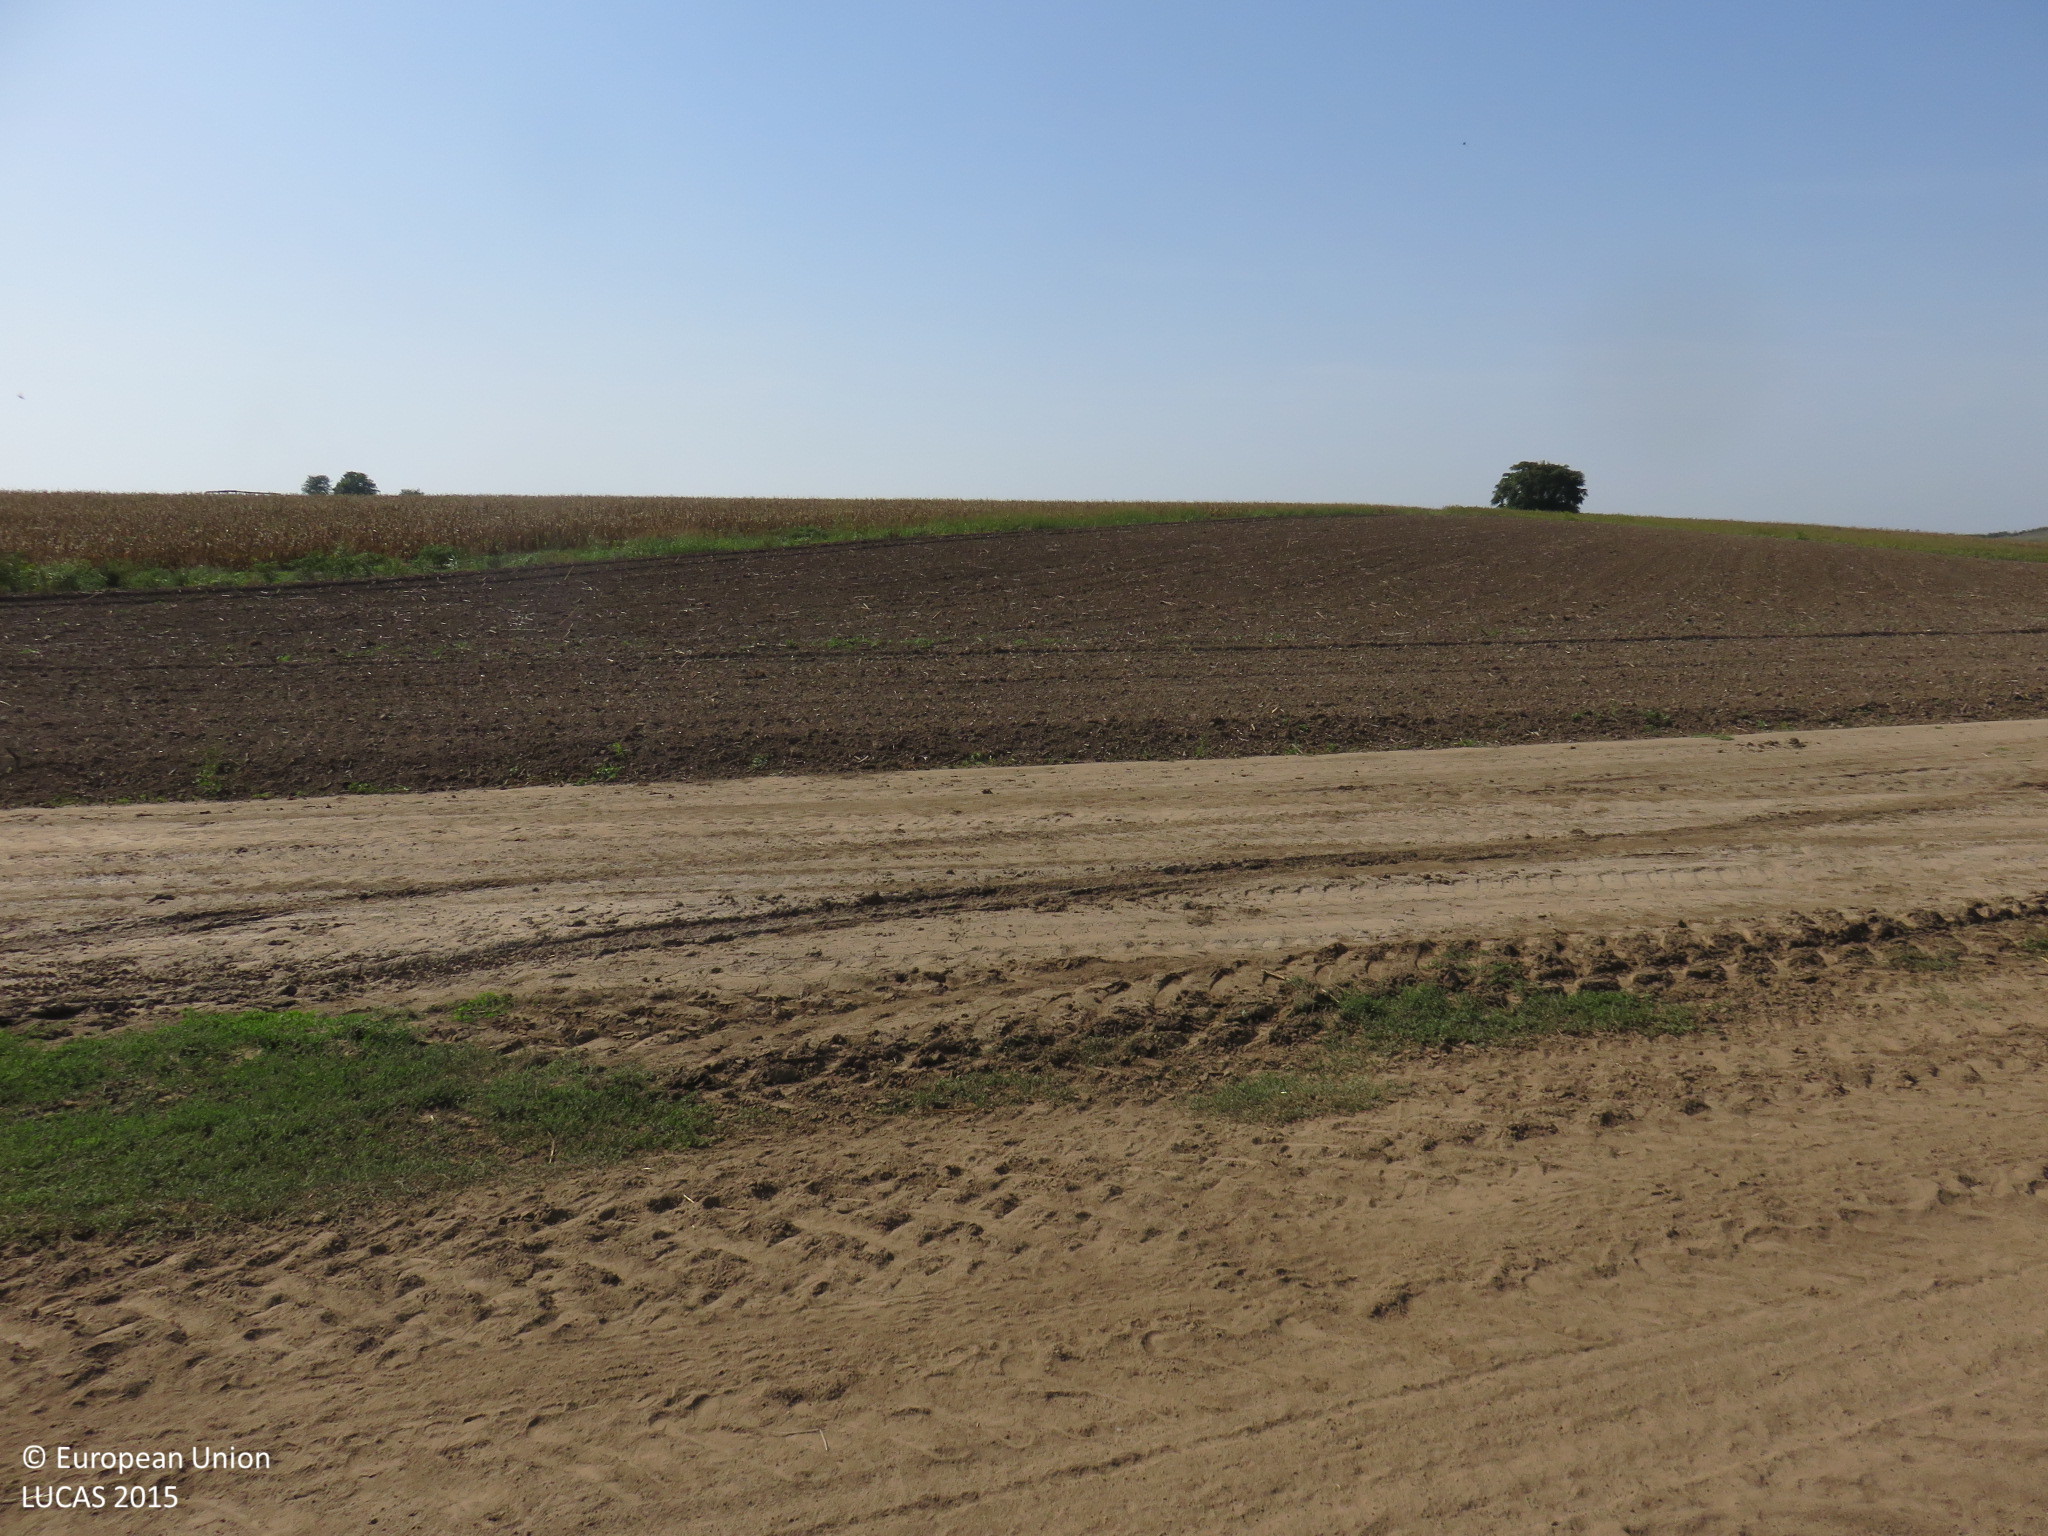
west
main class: Cropland
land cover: Maize
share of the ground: > 75 %
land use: Agriculture (excluding fallow land and kitchen gardens)
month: September
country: BG
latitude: 43.5518
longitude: 24.5832
